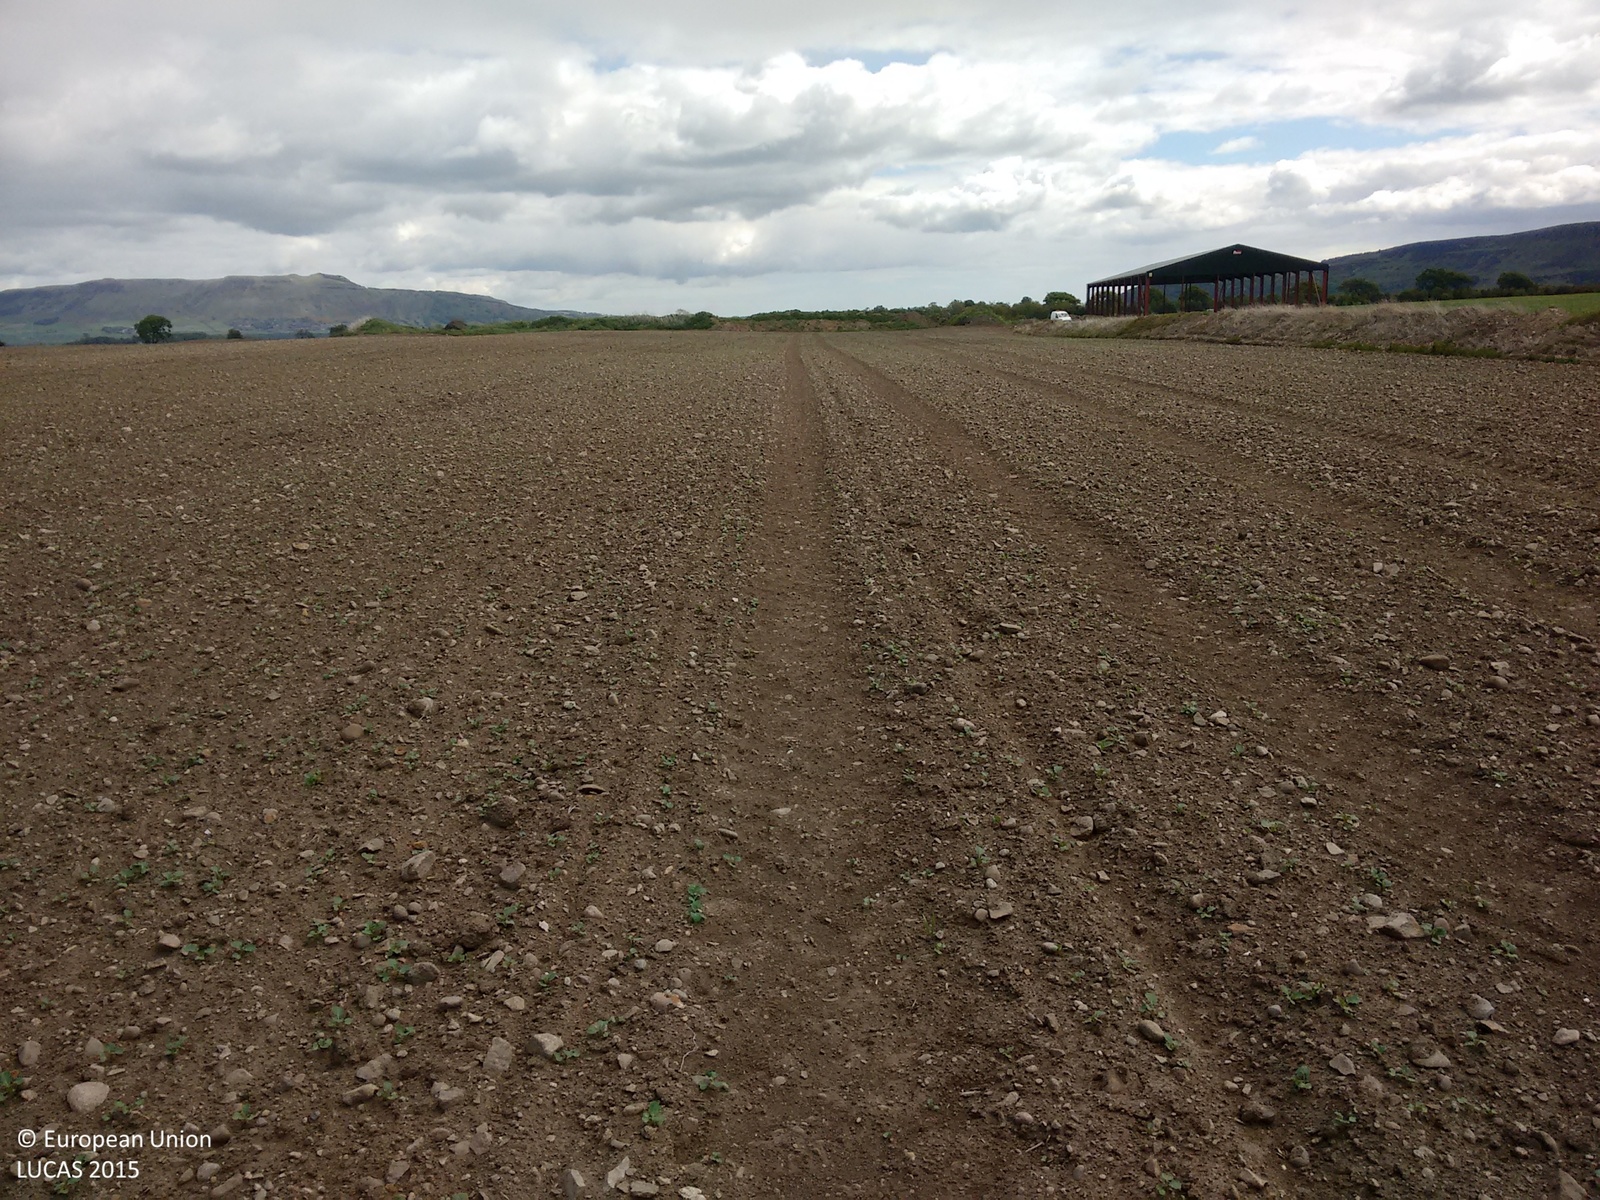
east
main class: Cropland
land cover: Rape and turnip rape
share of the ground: 10 - 25 %
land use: Agriculture (excluding fallow land and kitchen gardens)
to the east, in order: Rape and turnip rape; Grassland without tree/shrub cover; Other bare soil
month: June
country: GB
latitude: 56.1892
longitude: -3.4333
